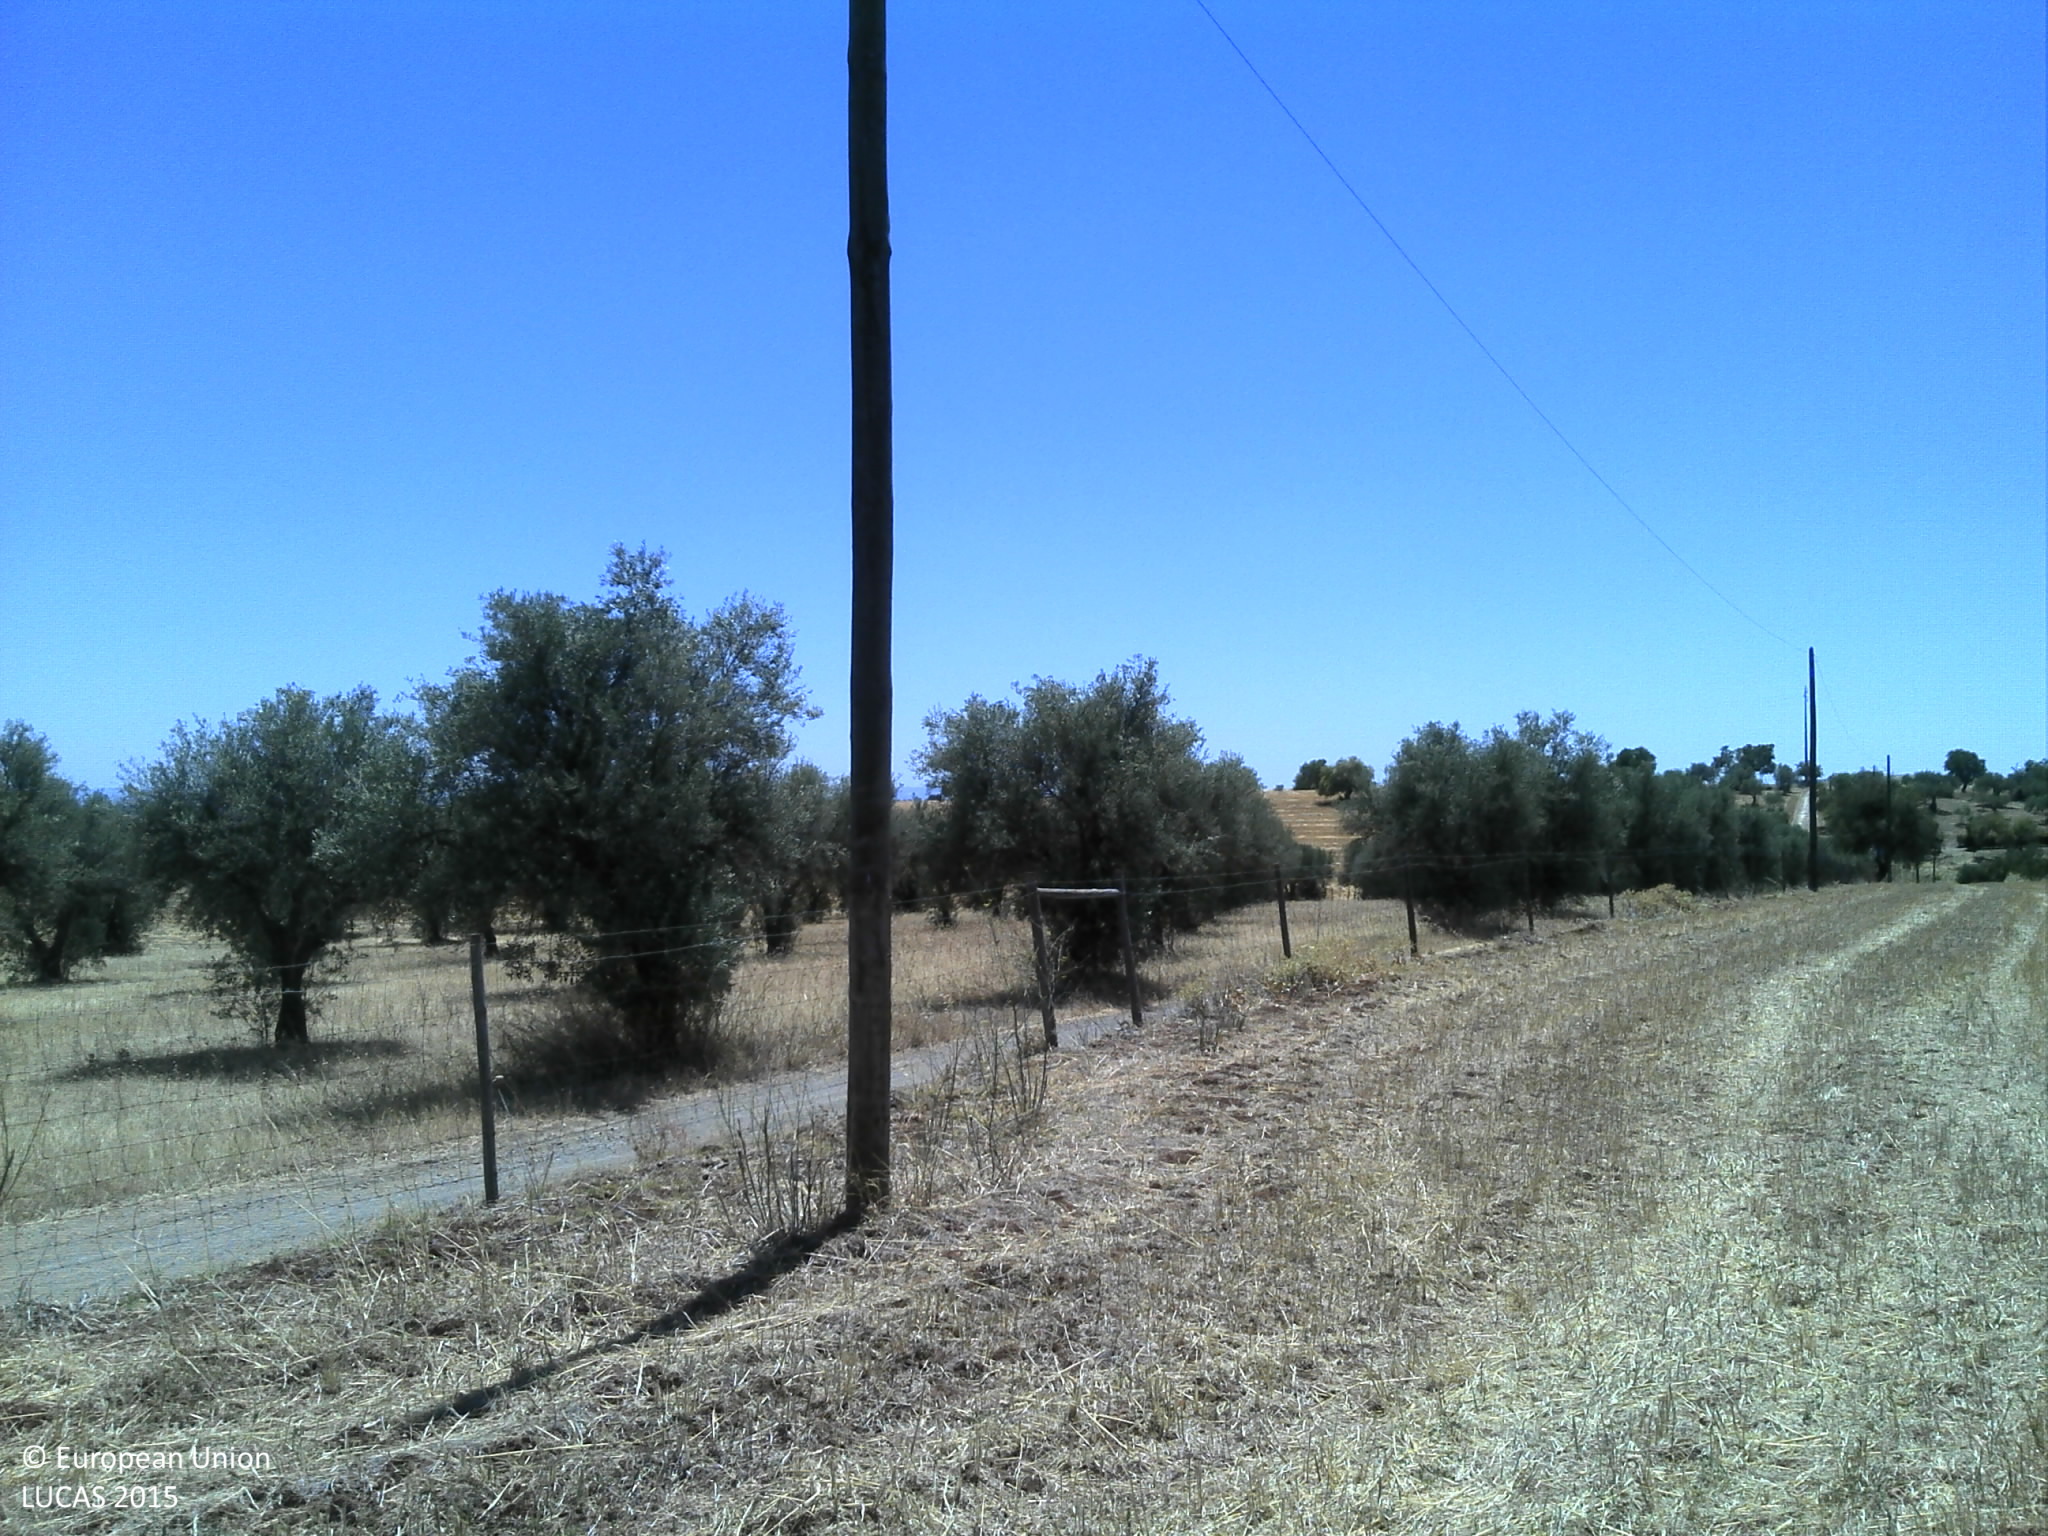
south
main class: Cropland
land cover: Oats
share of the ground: 10 - 25 %
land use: Agriculture (excluding fallow land and kitchen gardens)
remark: Harvested field
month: July
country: PT
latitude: 38.9965
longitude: -7.0819
